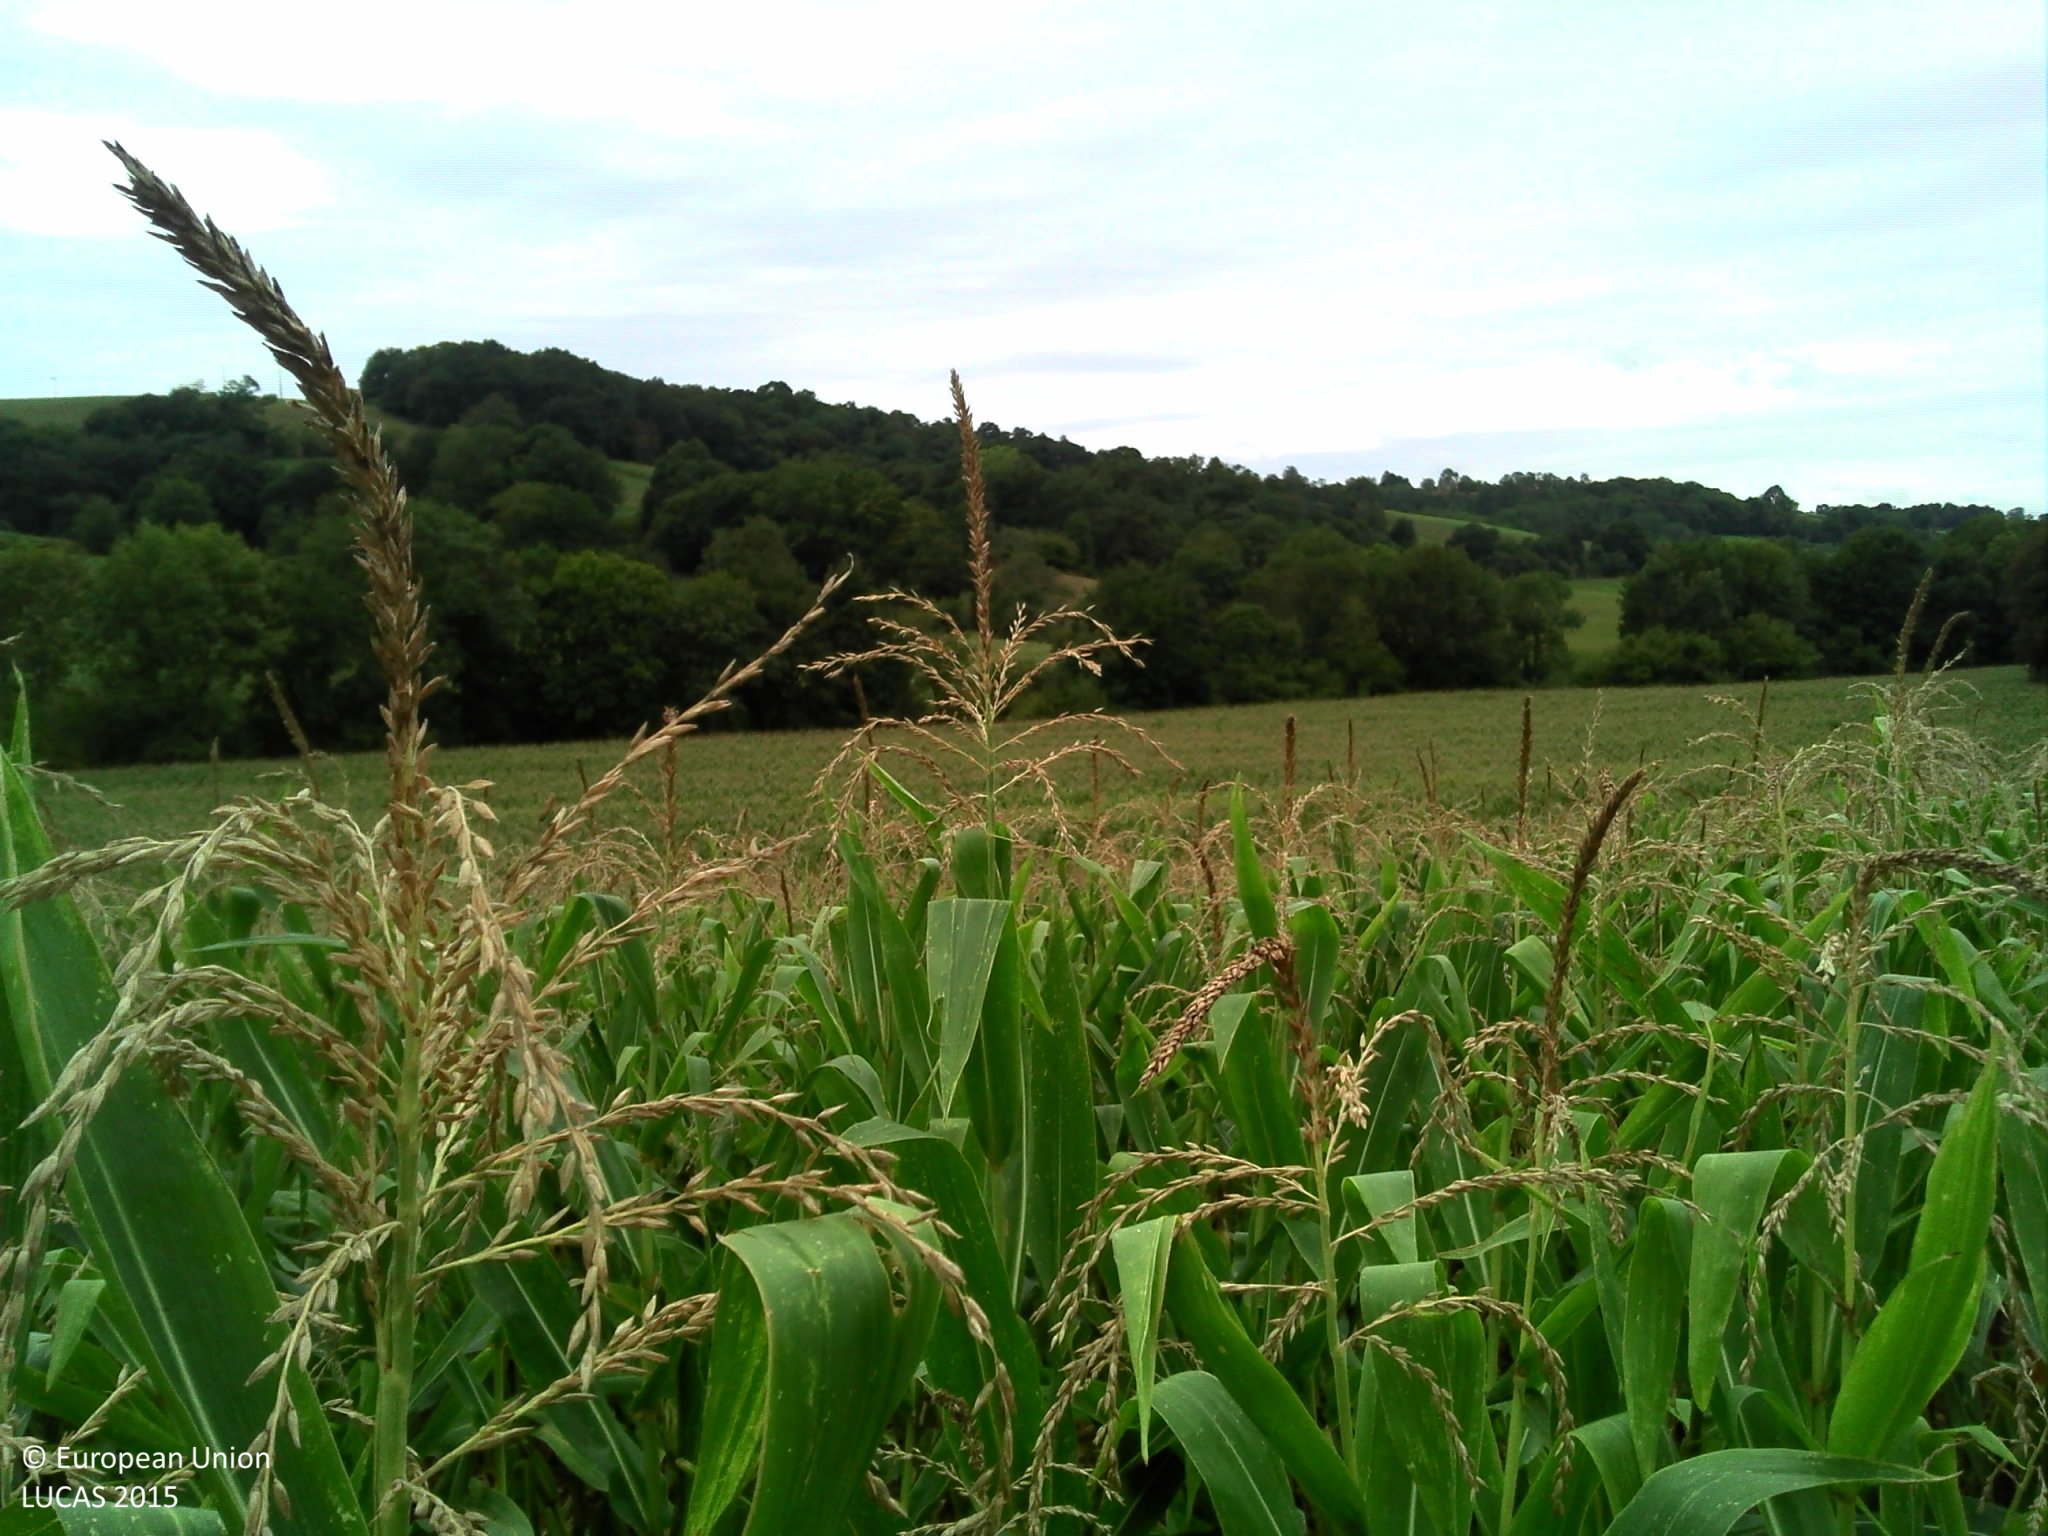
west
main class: Cropland
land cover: Maize
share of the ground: > 75 %
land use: Agriculture (excluding fallow land and kitchen gardens)
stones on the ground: 10 - 25 %
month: September
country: FR
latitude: 43.4628
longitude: -0.4028
